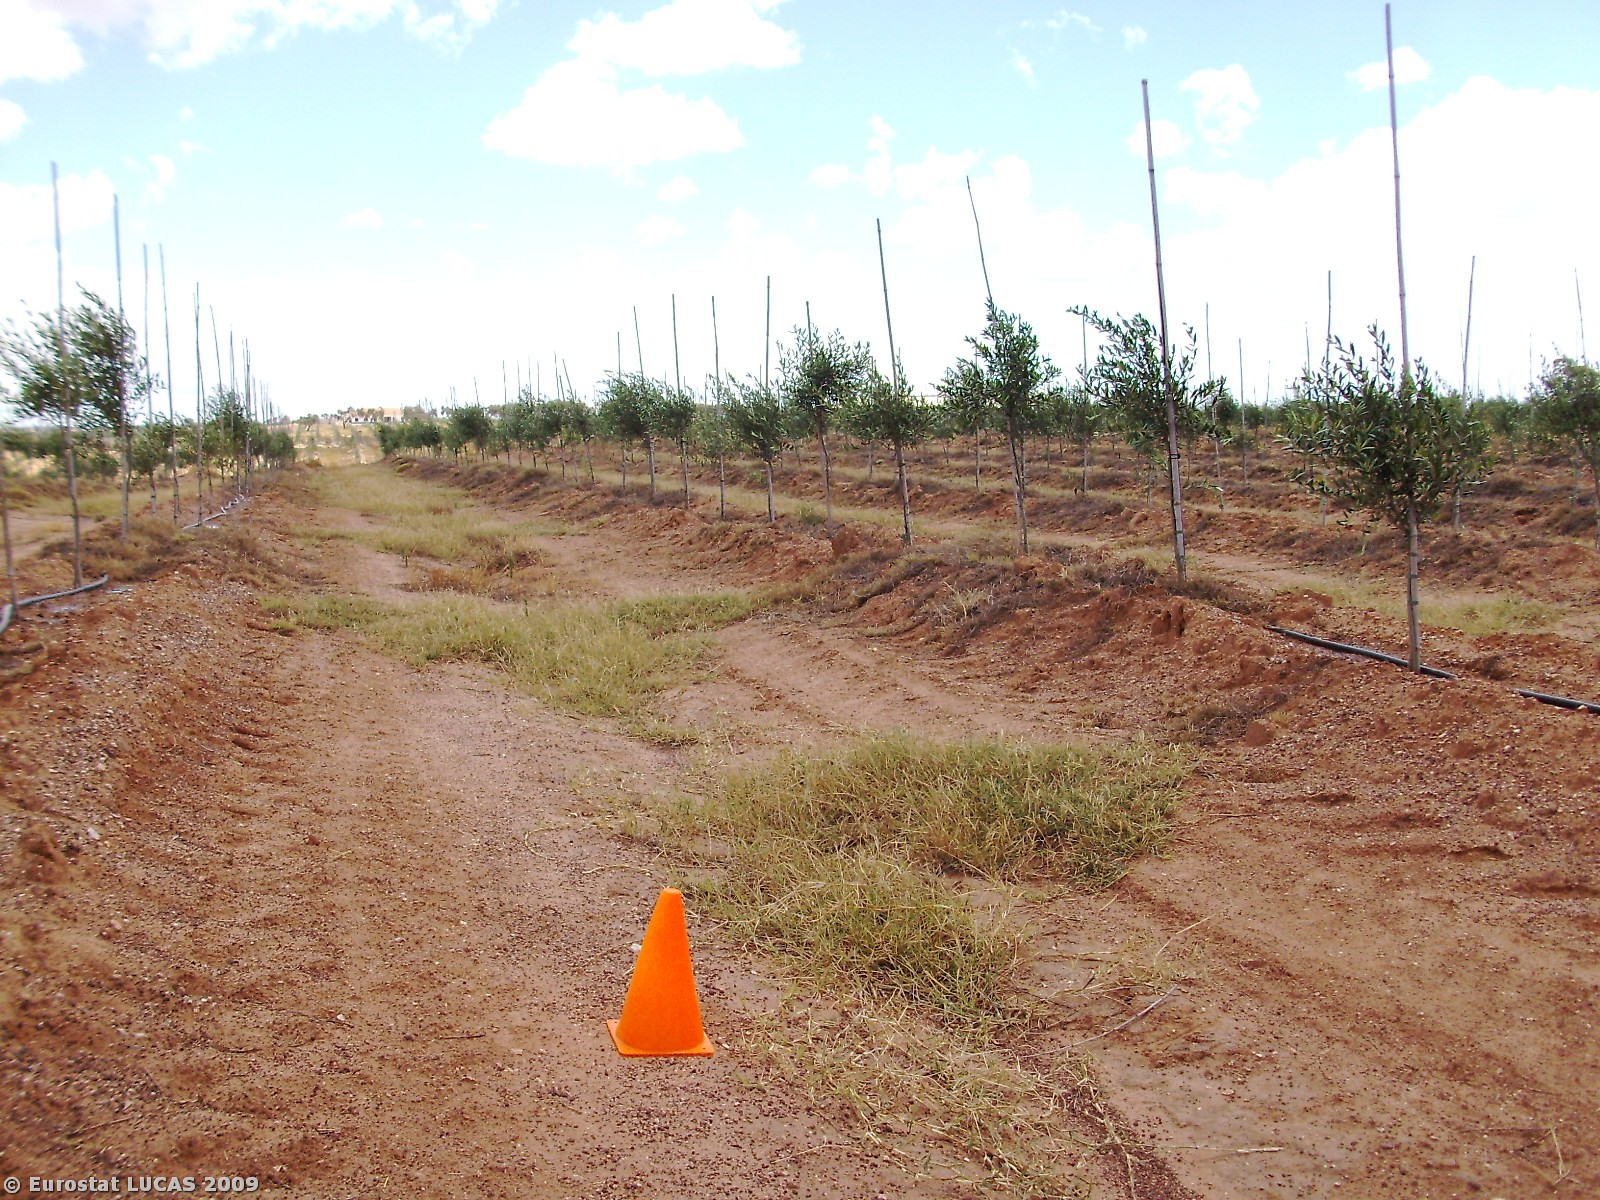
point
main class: Cropland
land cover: Olive groves
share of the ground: 10 - 25 %
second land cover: Bare land
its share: > 75 %
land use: Agriculture (excluding fallow land and kitchen gardens)
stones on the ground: 25 - 50 %
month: June
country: PT
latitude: 37.9551
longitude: -8.3036
